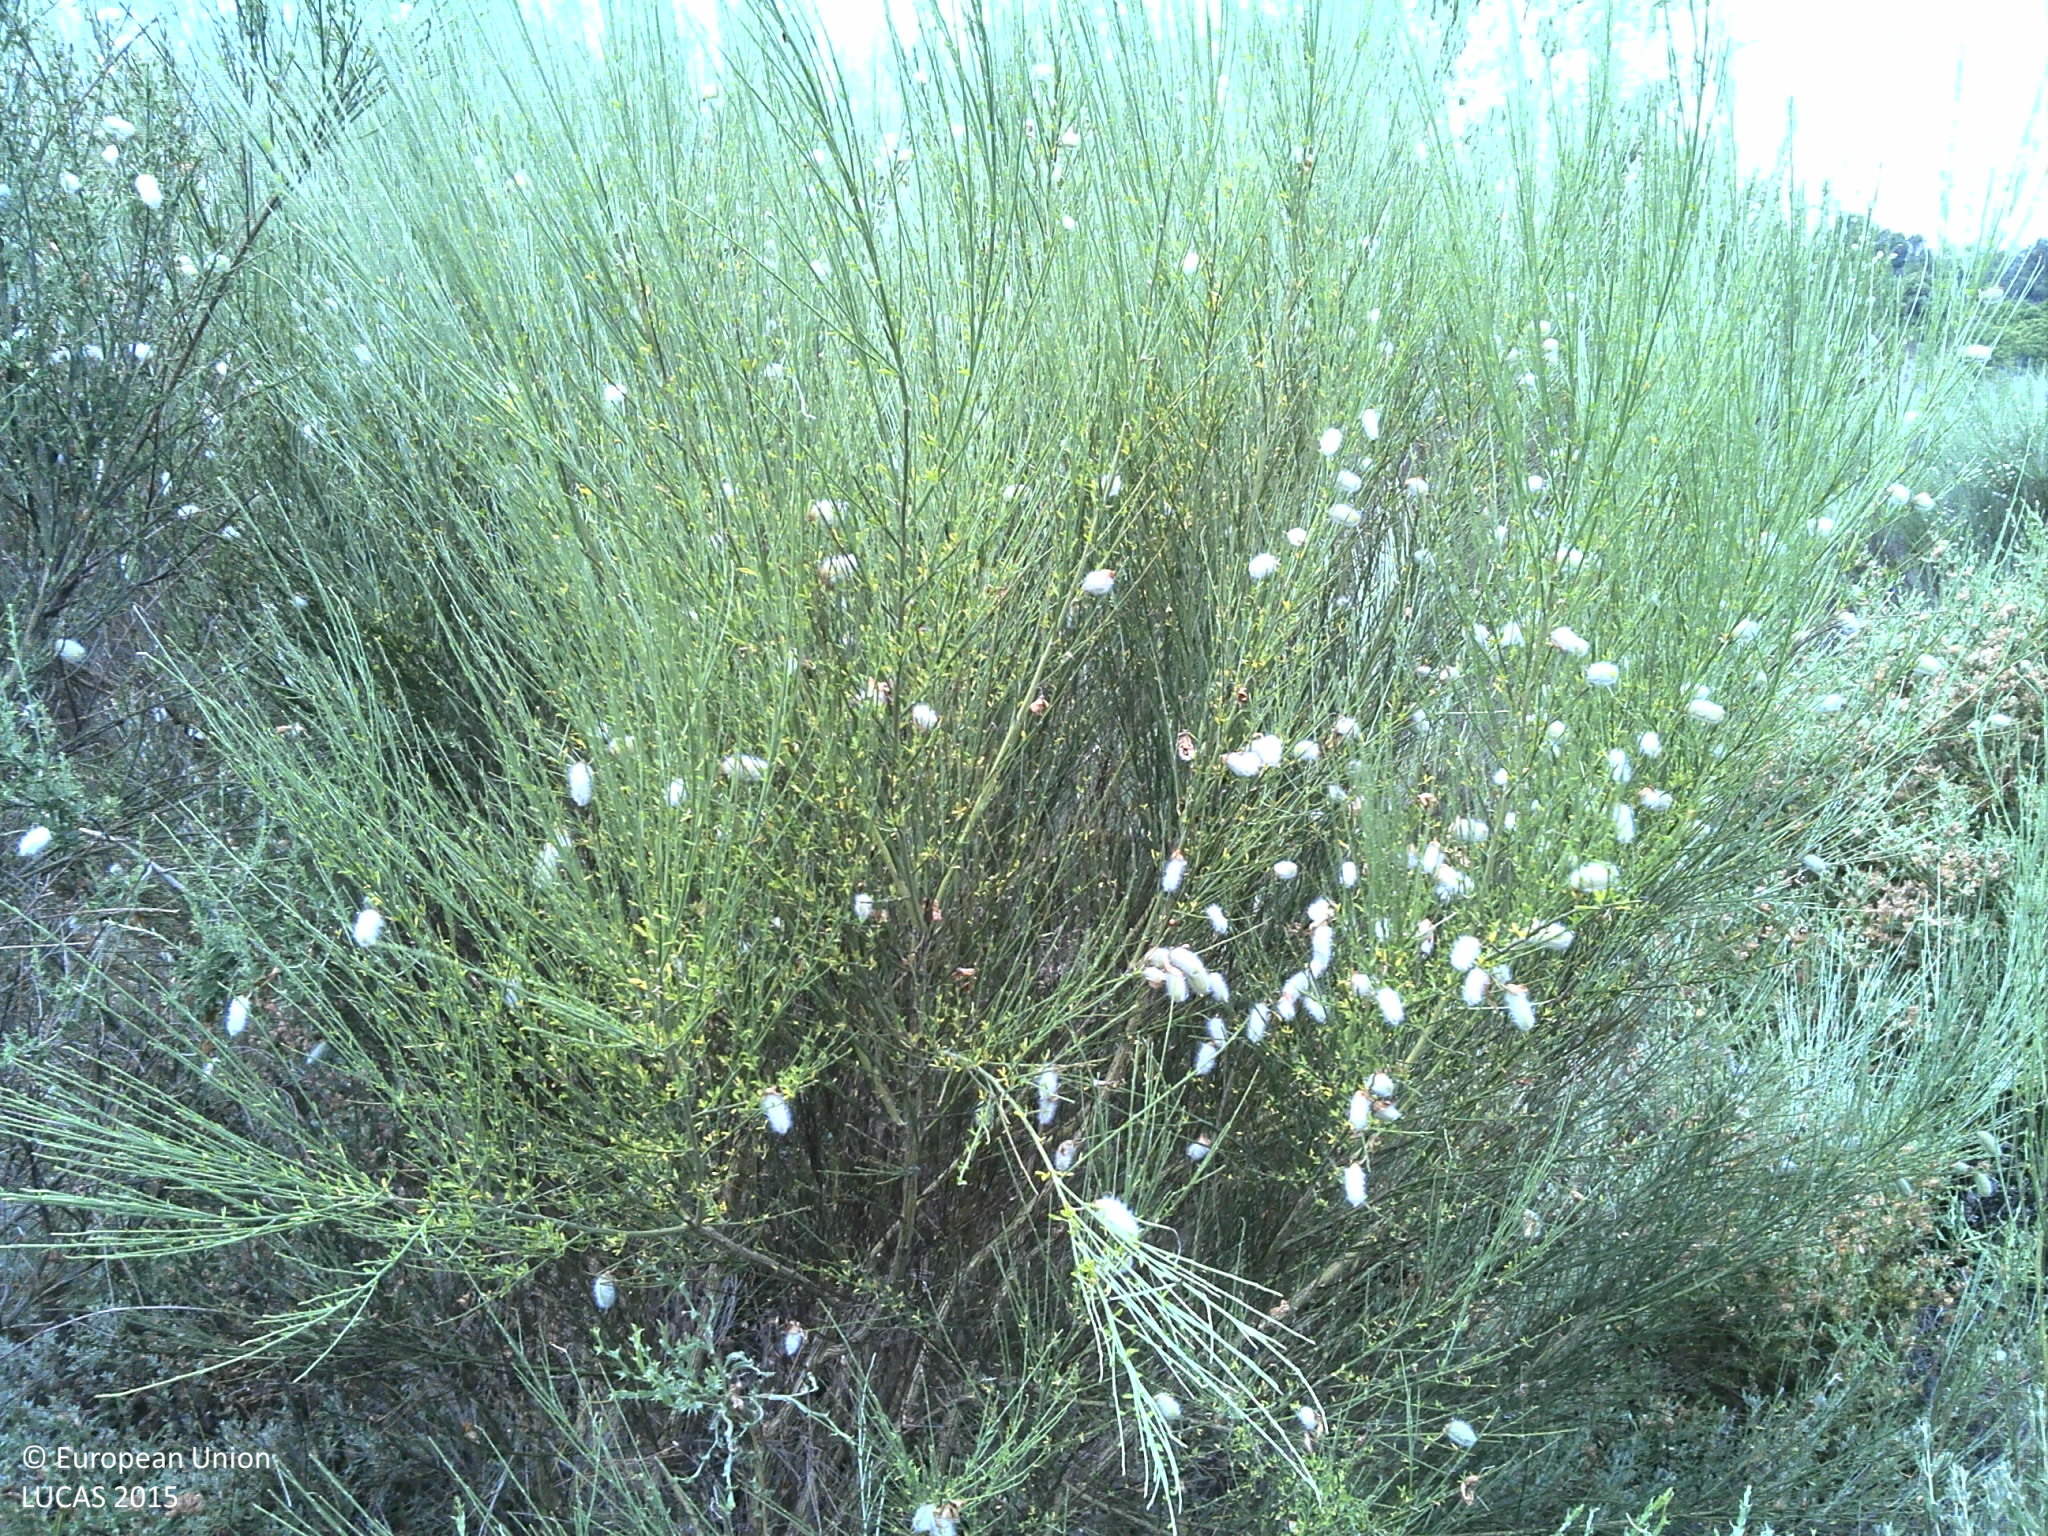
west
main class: Shrubland
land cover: Shrubland without tree cover
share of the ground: > 75 %
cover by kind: shrubs 90 %, unconsolidated bare surface 10 %
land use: Semi-natural and natural areas not in use
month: June
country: PT
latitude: 41.4751
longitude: -7.4533
